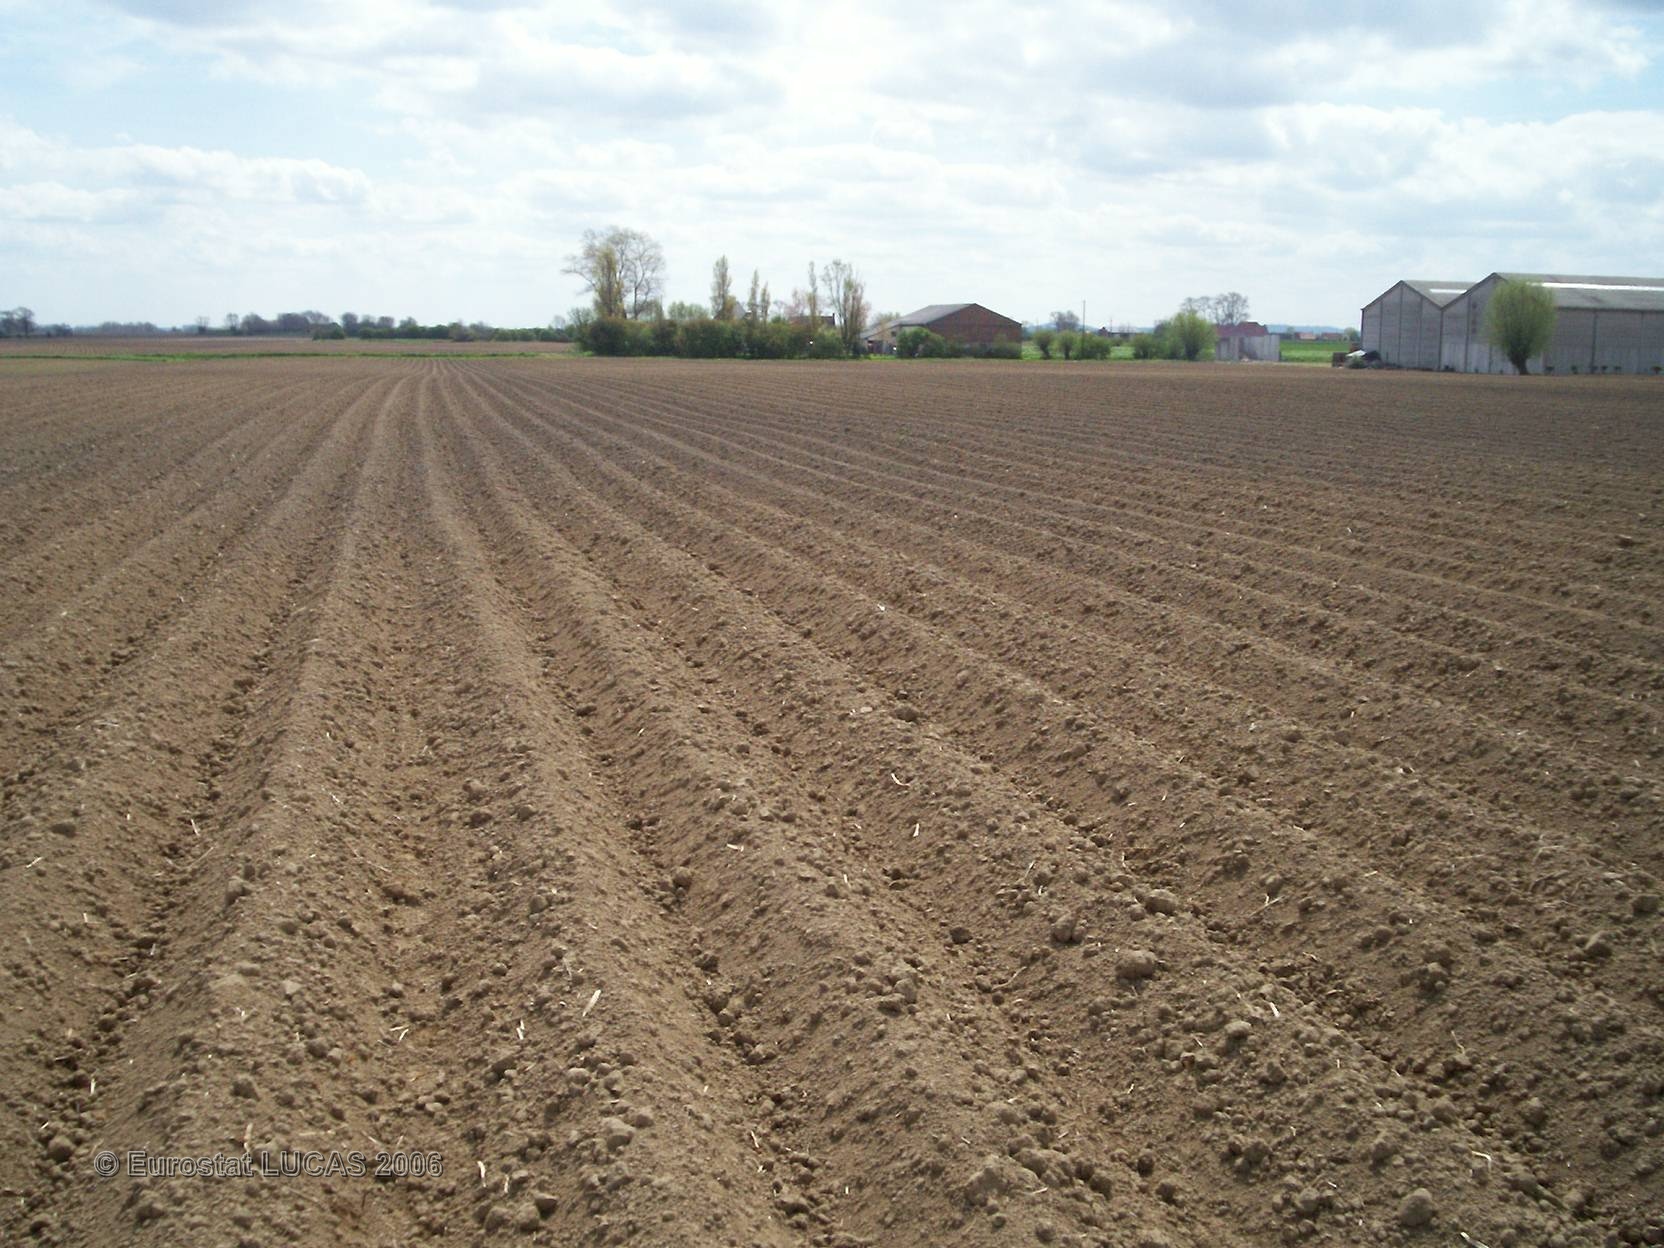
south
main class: Cropland
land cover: Potatoes
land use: Agriculture (excluding fallow land and kitchen gardens)
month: May
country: FR
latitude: 50.9333
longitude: 2.5456
